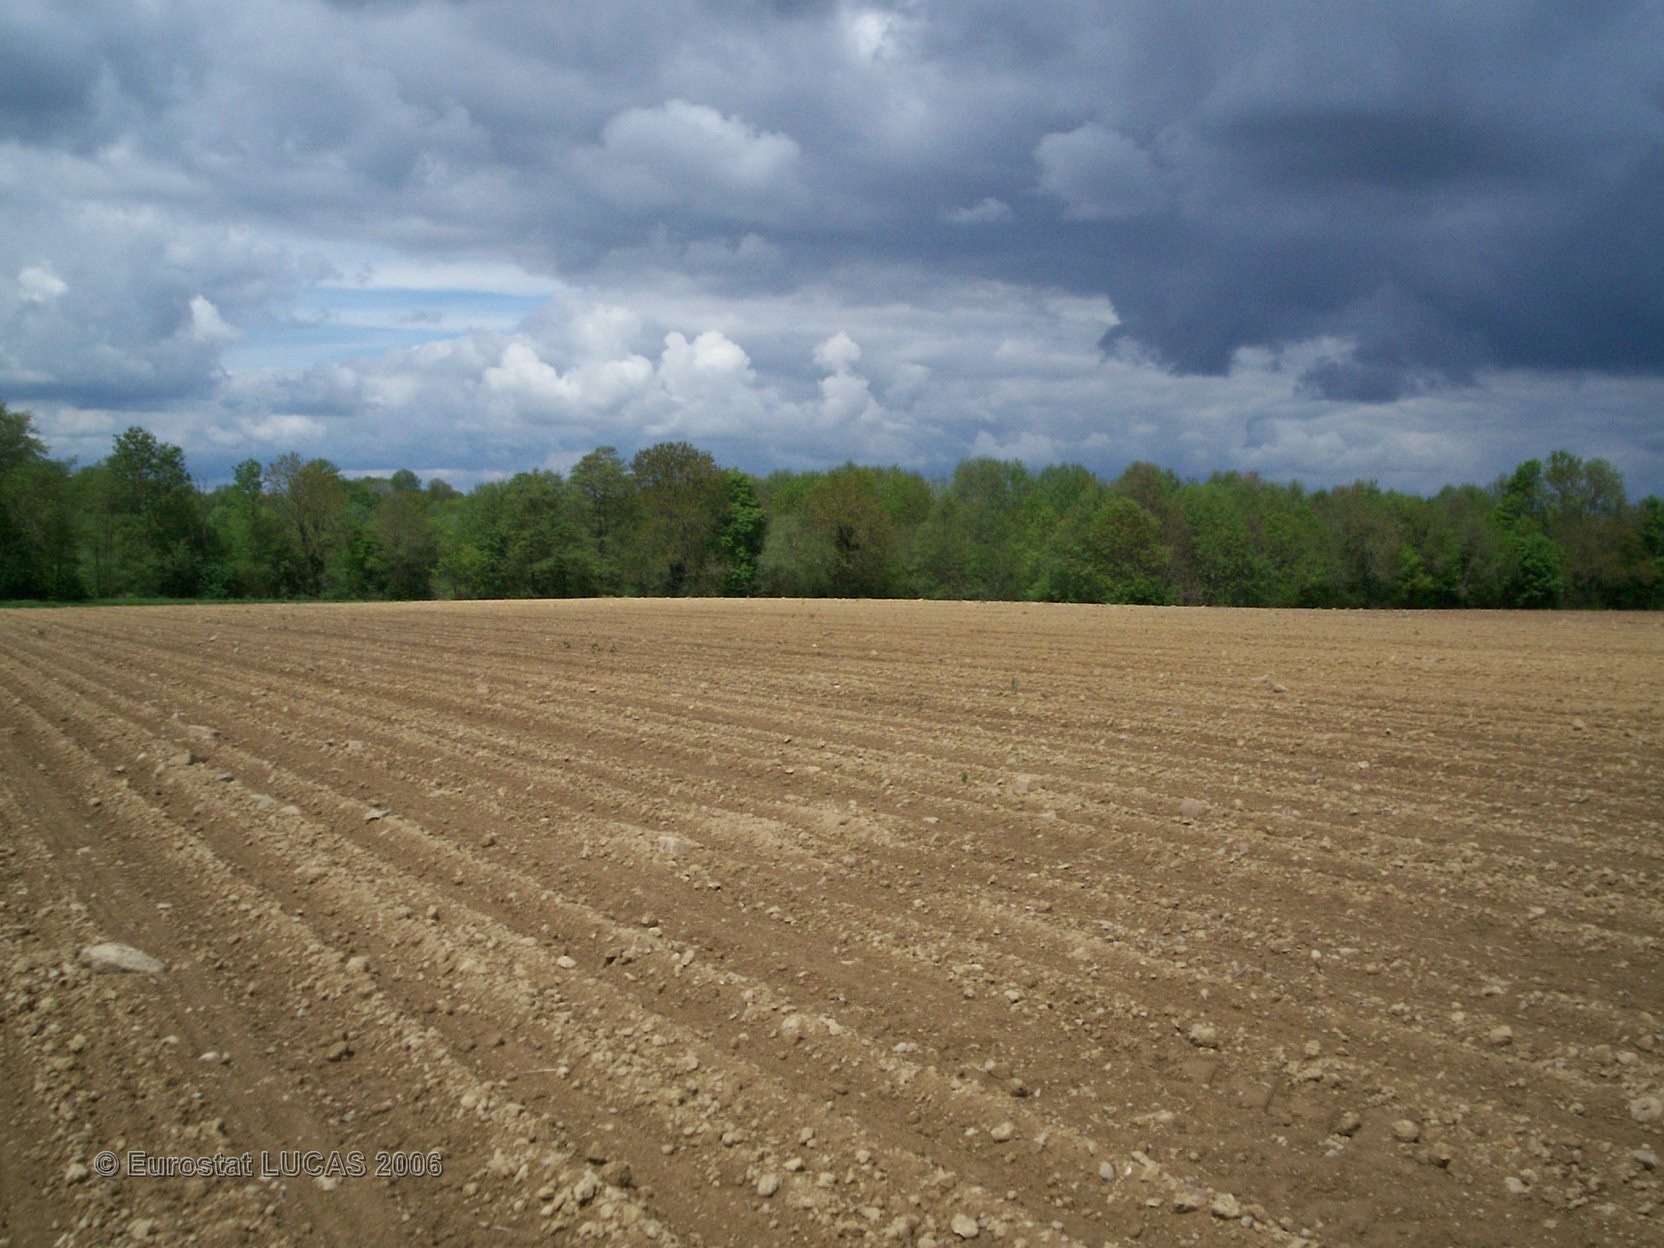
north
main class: Cropland
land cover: Maize
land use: Agriculture (excluding fallow land and kitchen gardens)
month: May
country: FR
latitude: 48.6246
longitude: 0.0532
